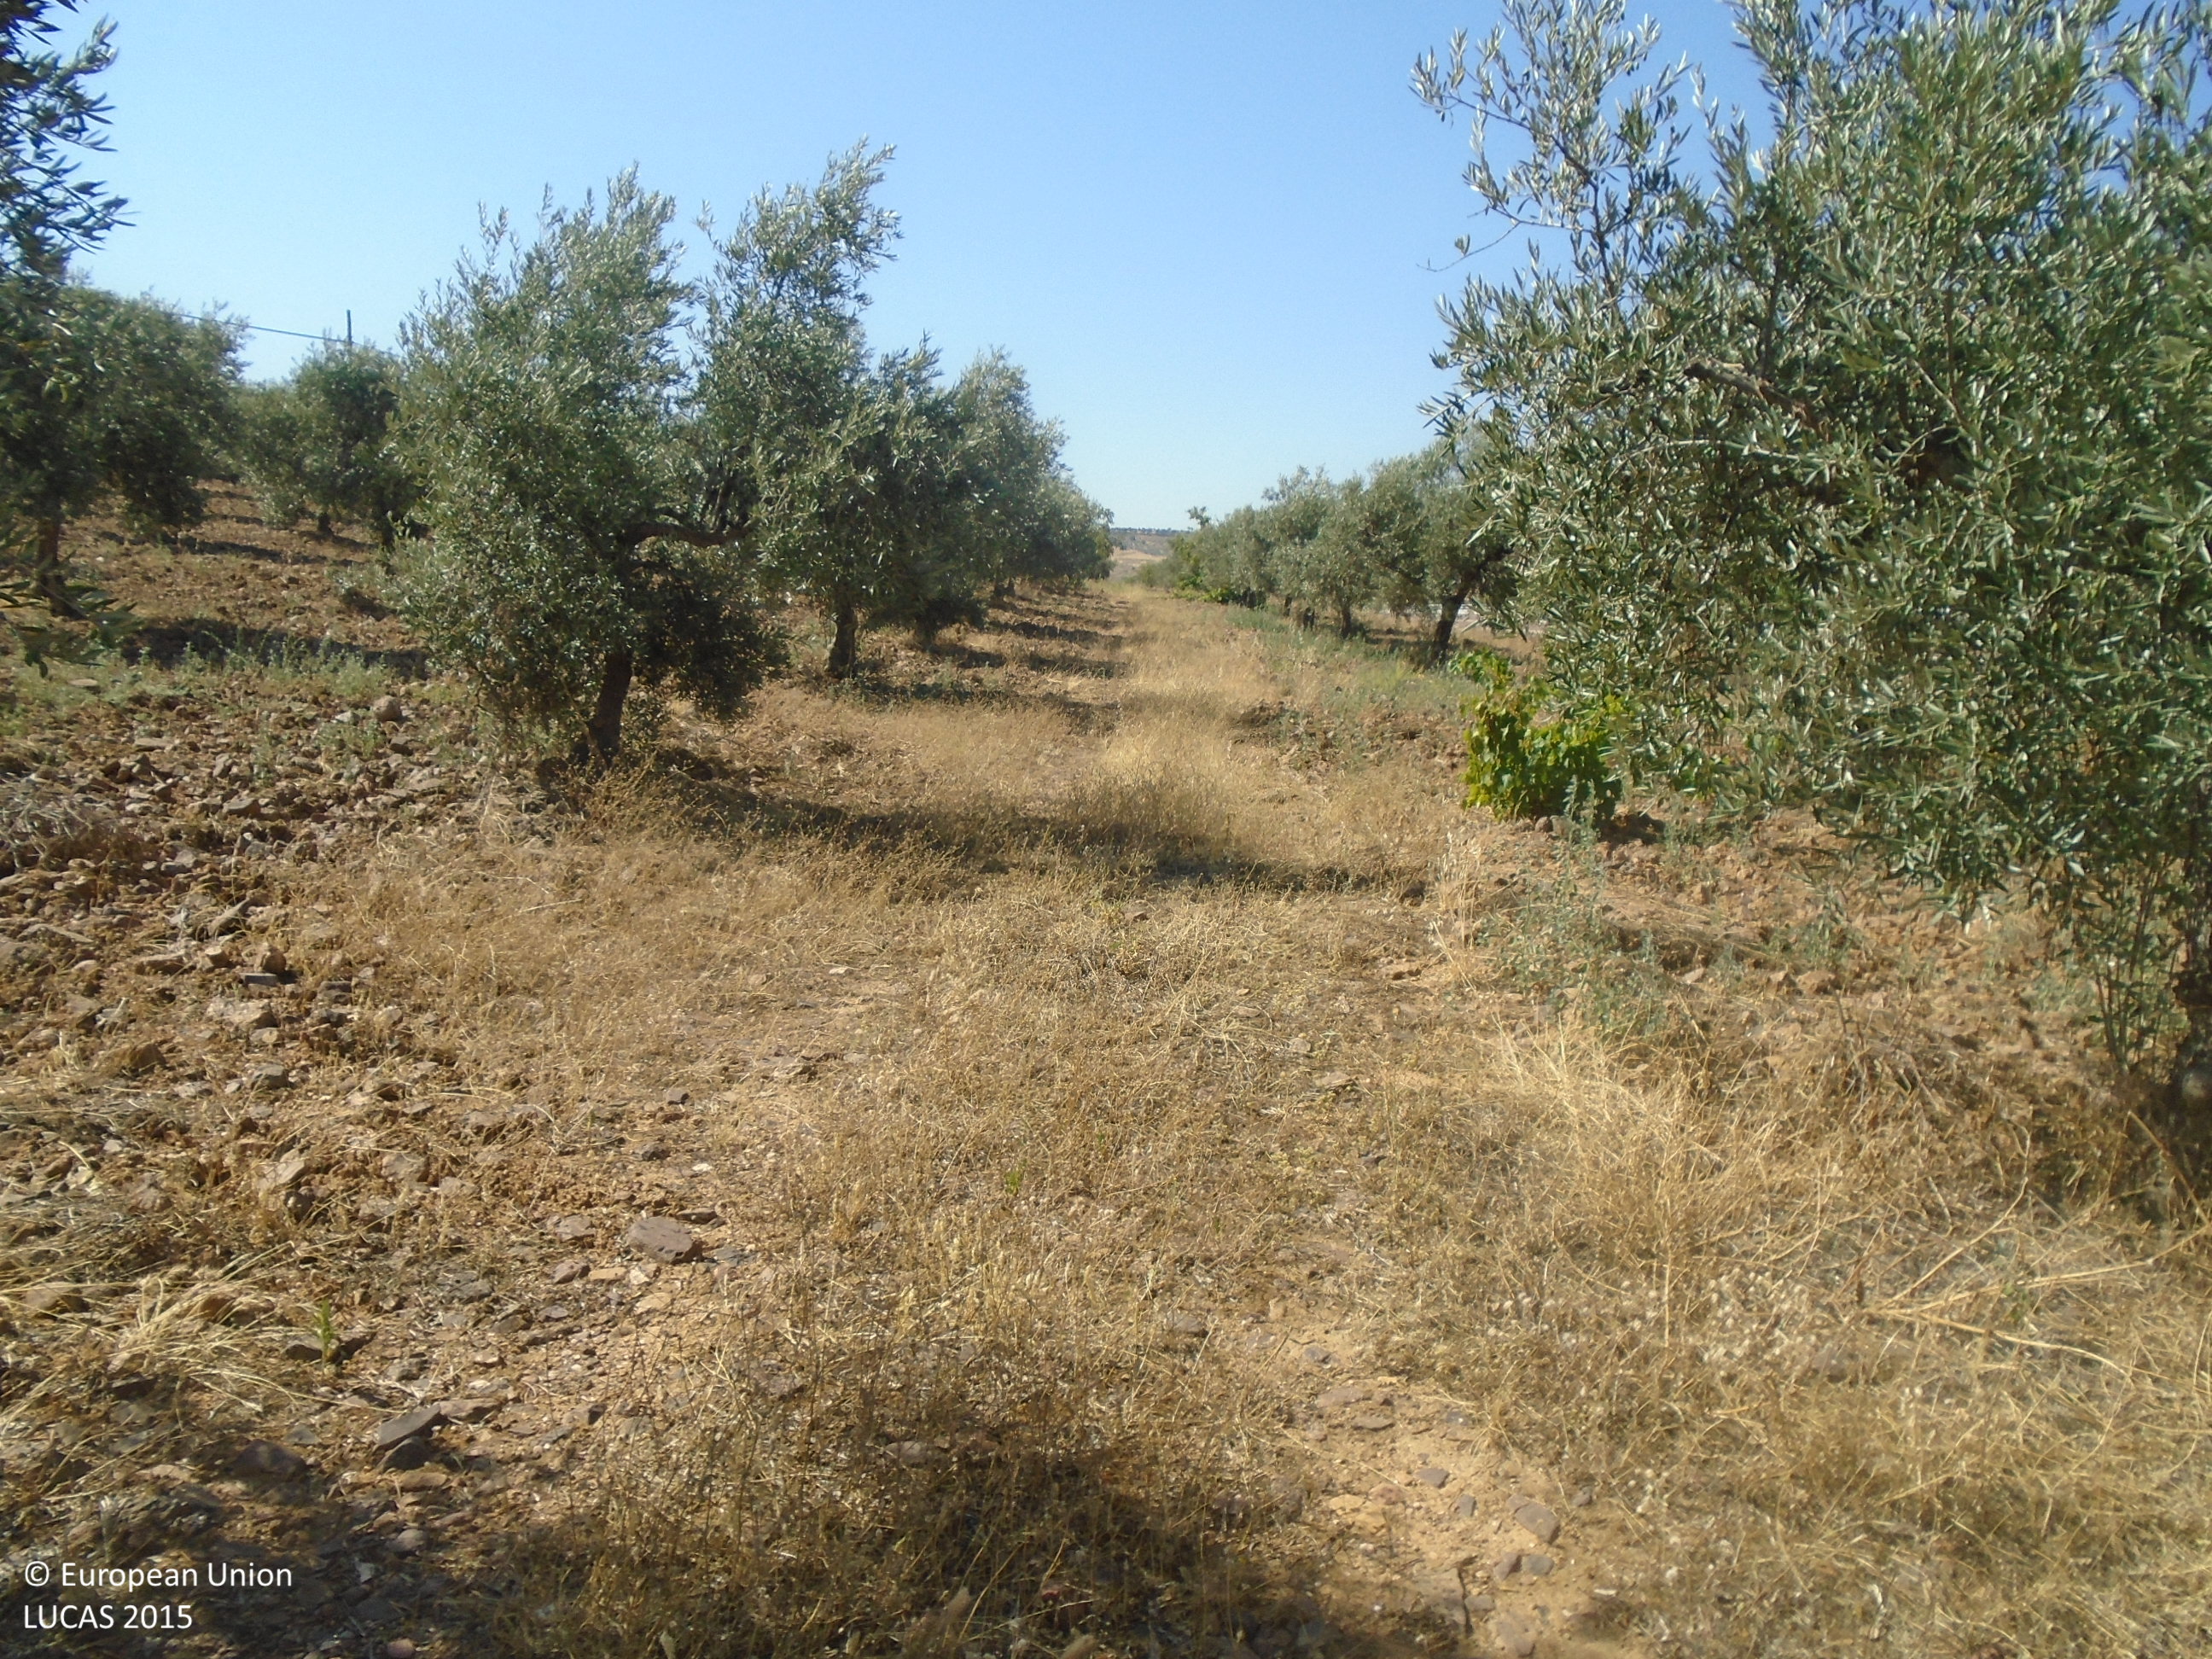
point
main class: Cropland
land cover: Olive groves
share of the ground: 10 - 25 %
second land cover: Spontaneously vegetated surfaces
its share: > 75 %
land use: Agriculture (excluding fallow land and kitchen gardens)
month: July
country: ES
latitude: 39.6401
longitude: -4.9956
